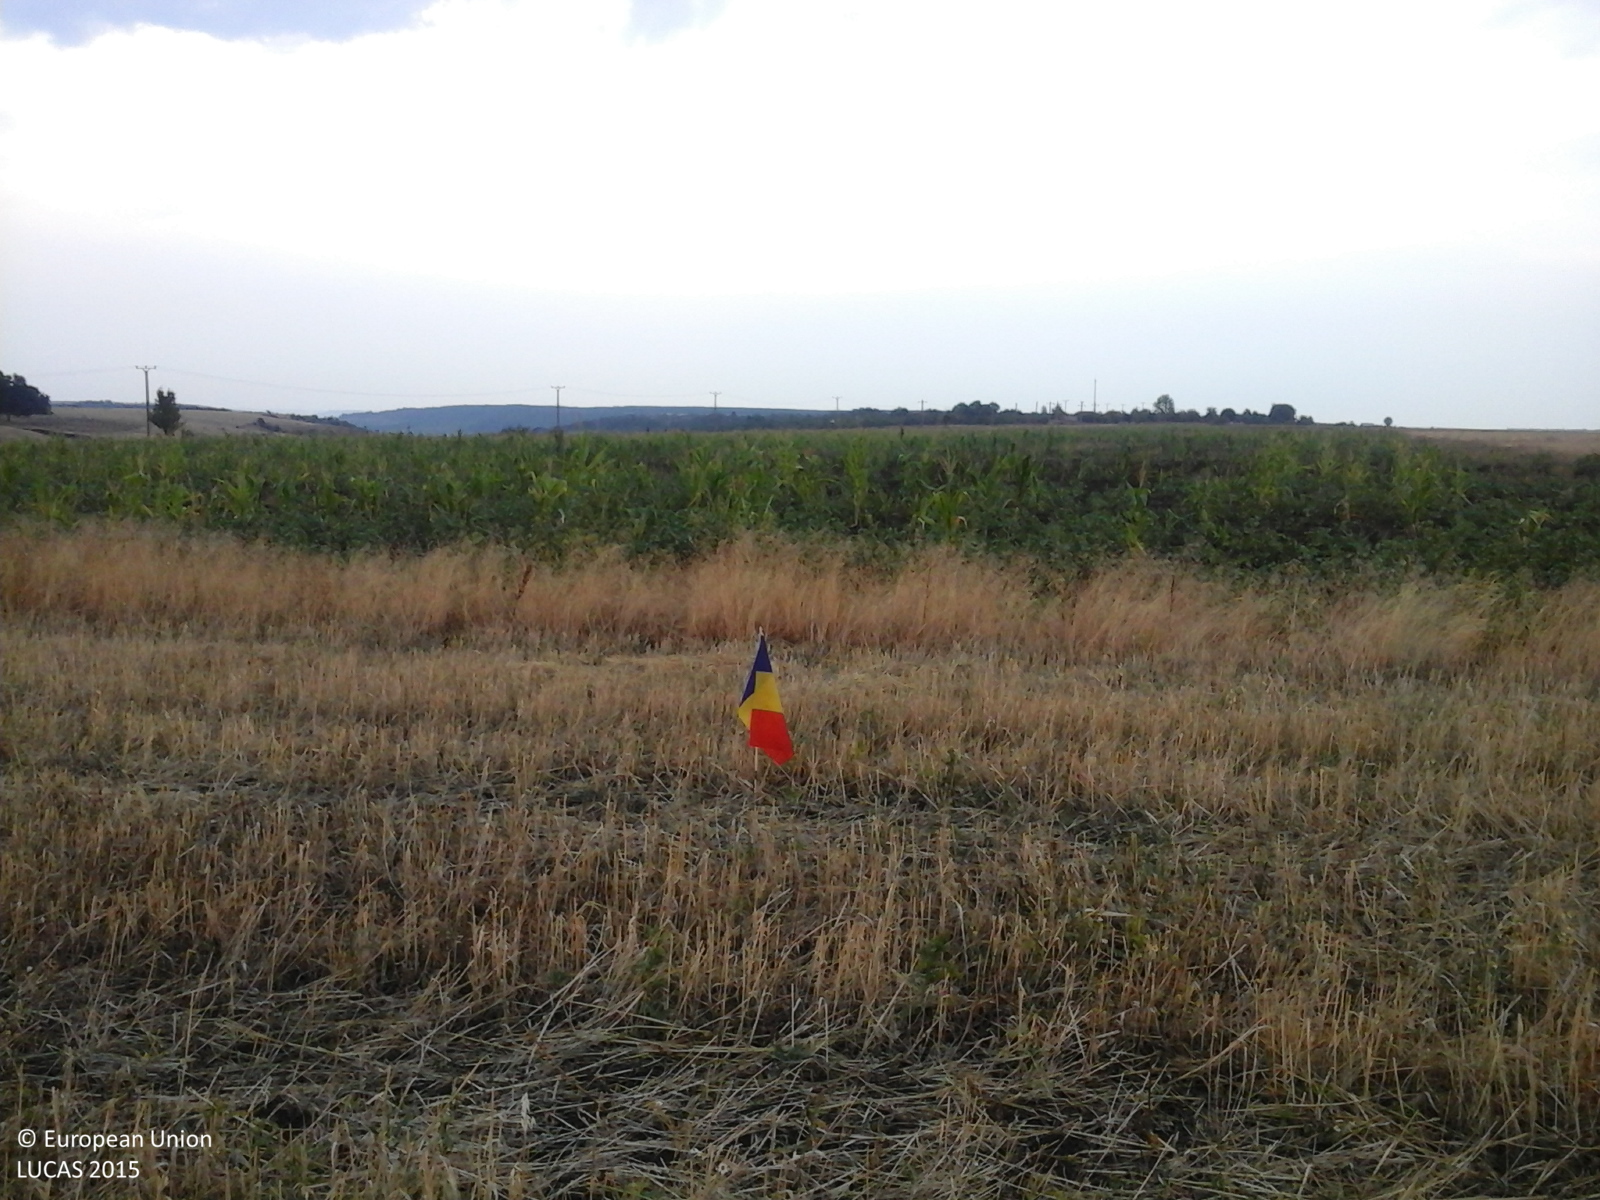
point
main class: Cropland
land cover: Mixed cereals for fodder
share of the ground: > 75 %
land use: Agriculture (excluding fallow land and kitchen gardens)
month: August
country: RO
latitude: 44.5332
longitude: 22.9947
